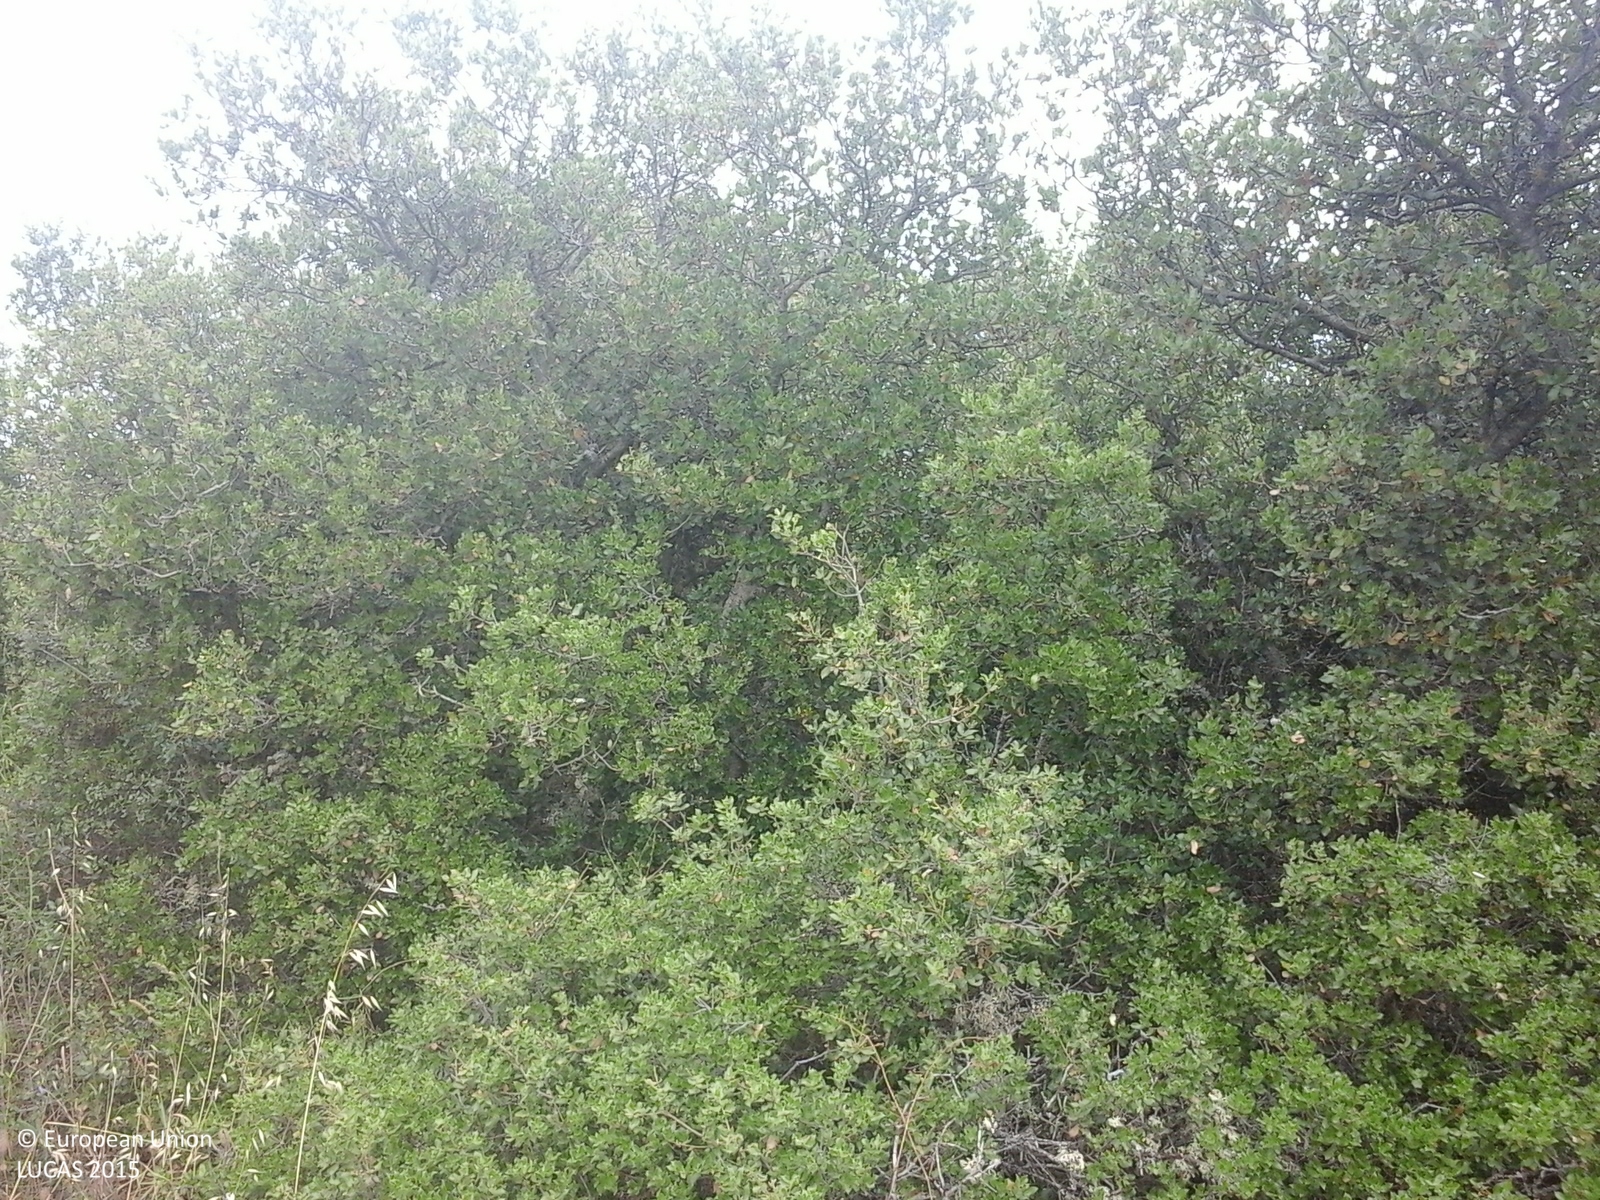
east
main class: Shrubland
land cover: Shrubland without tree cover
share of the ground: > 75 %
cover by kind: shrubs 80 %, herbaceous plants 20 %
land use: Semi-natural and natural areas not in use
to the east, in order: Shrubland without tree cover; Tracks; Shrubland without tree cover; Rivers and streams; Shrubland without tree cover
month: June
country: GR
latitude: 40.7478
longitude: 23.1693
